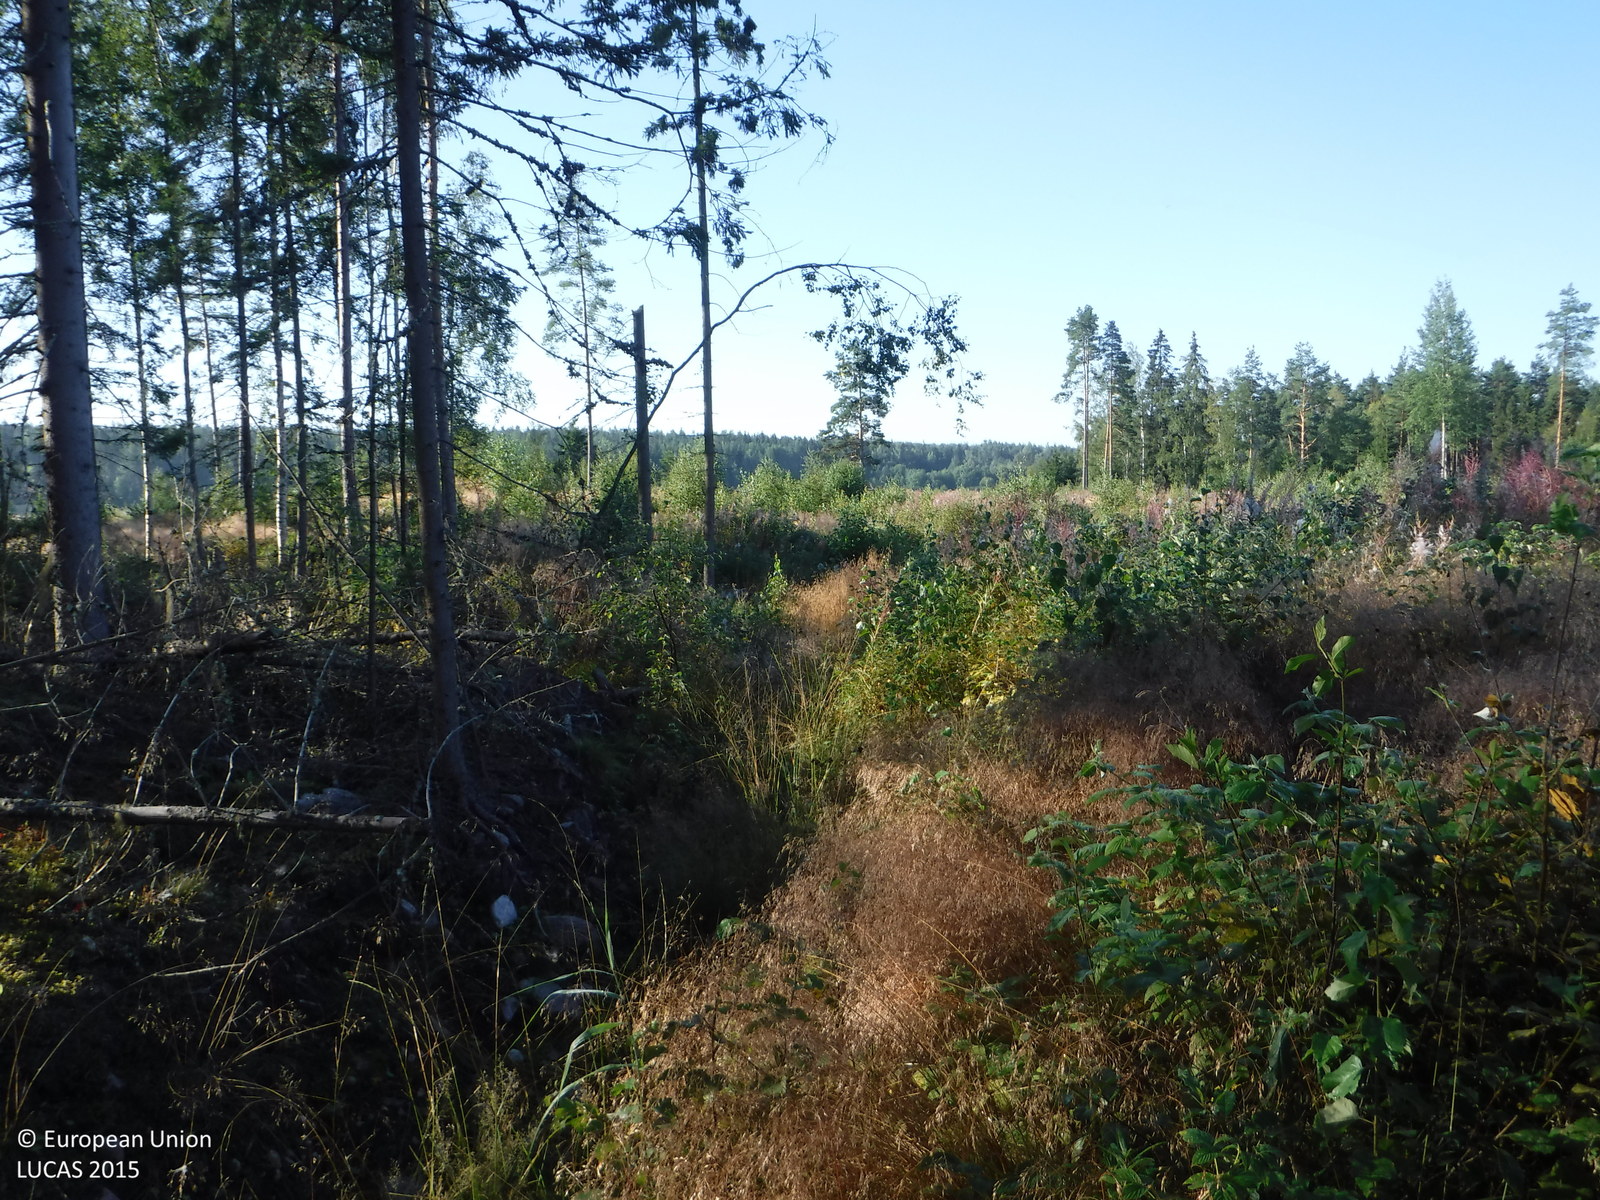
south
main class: Shrubland
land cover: Shrubland with sparse tree cover
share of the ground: 25 - 50 %
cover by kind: shrubs 40 %, herbaceous plants 40 %, broadleaved forest trees 5 %
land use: Forestry
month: August
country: FI
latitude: 61.1002
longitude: 21.6481
